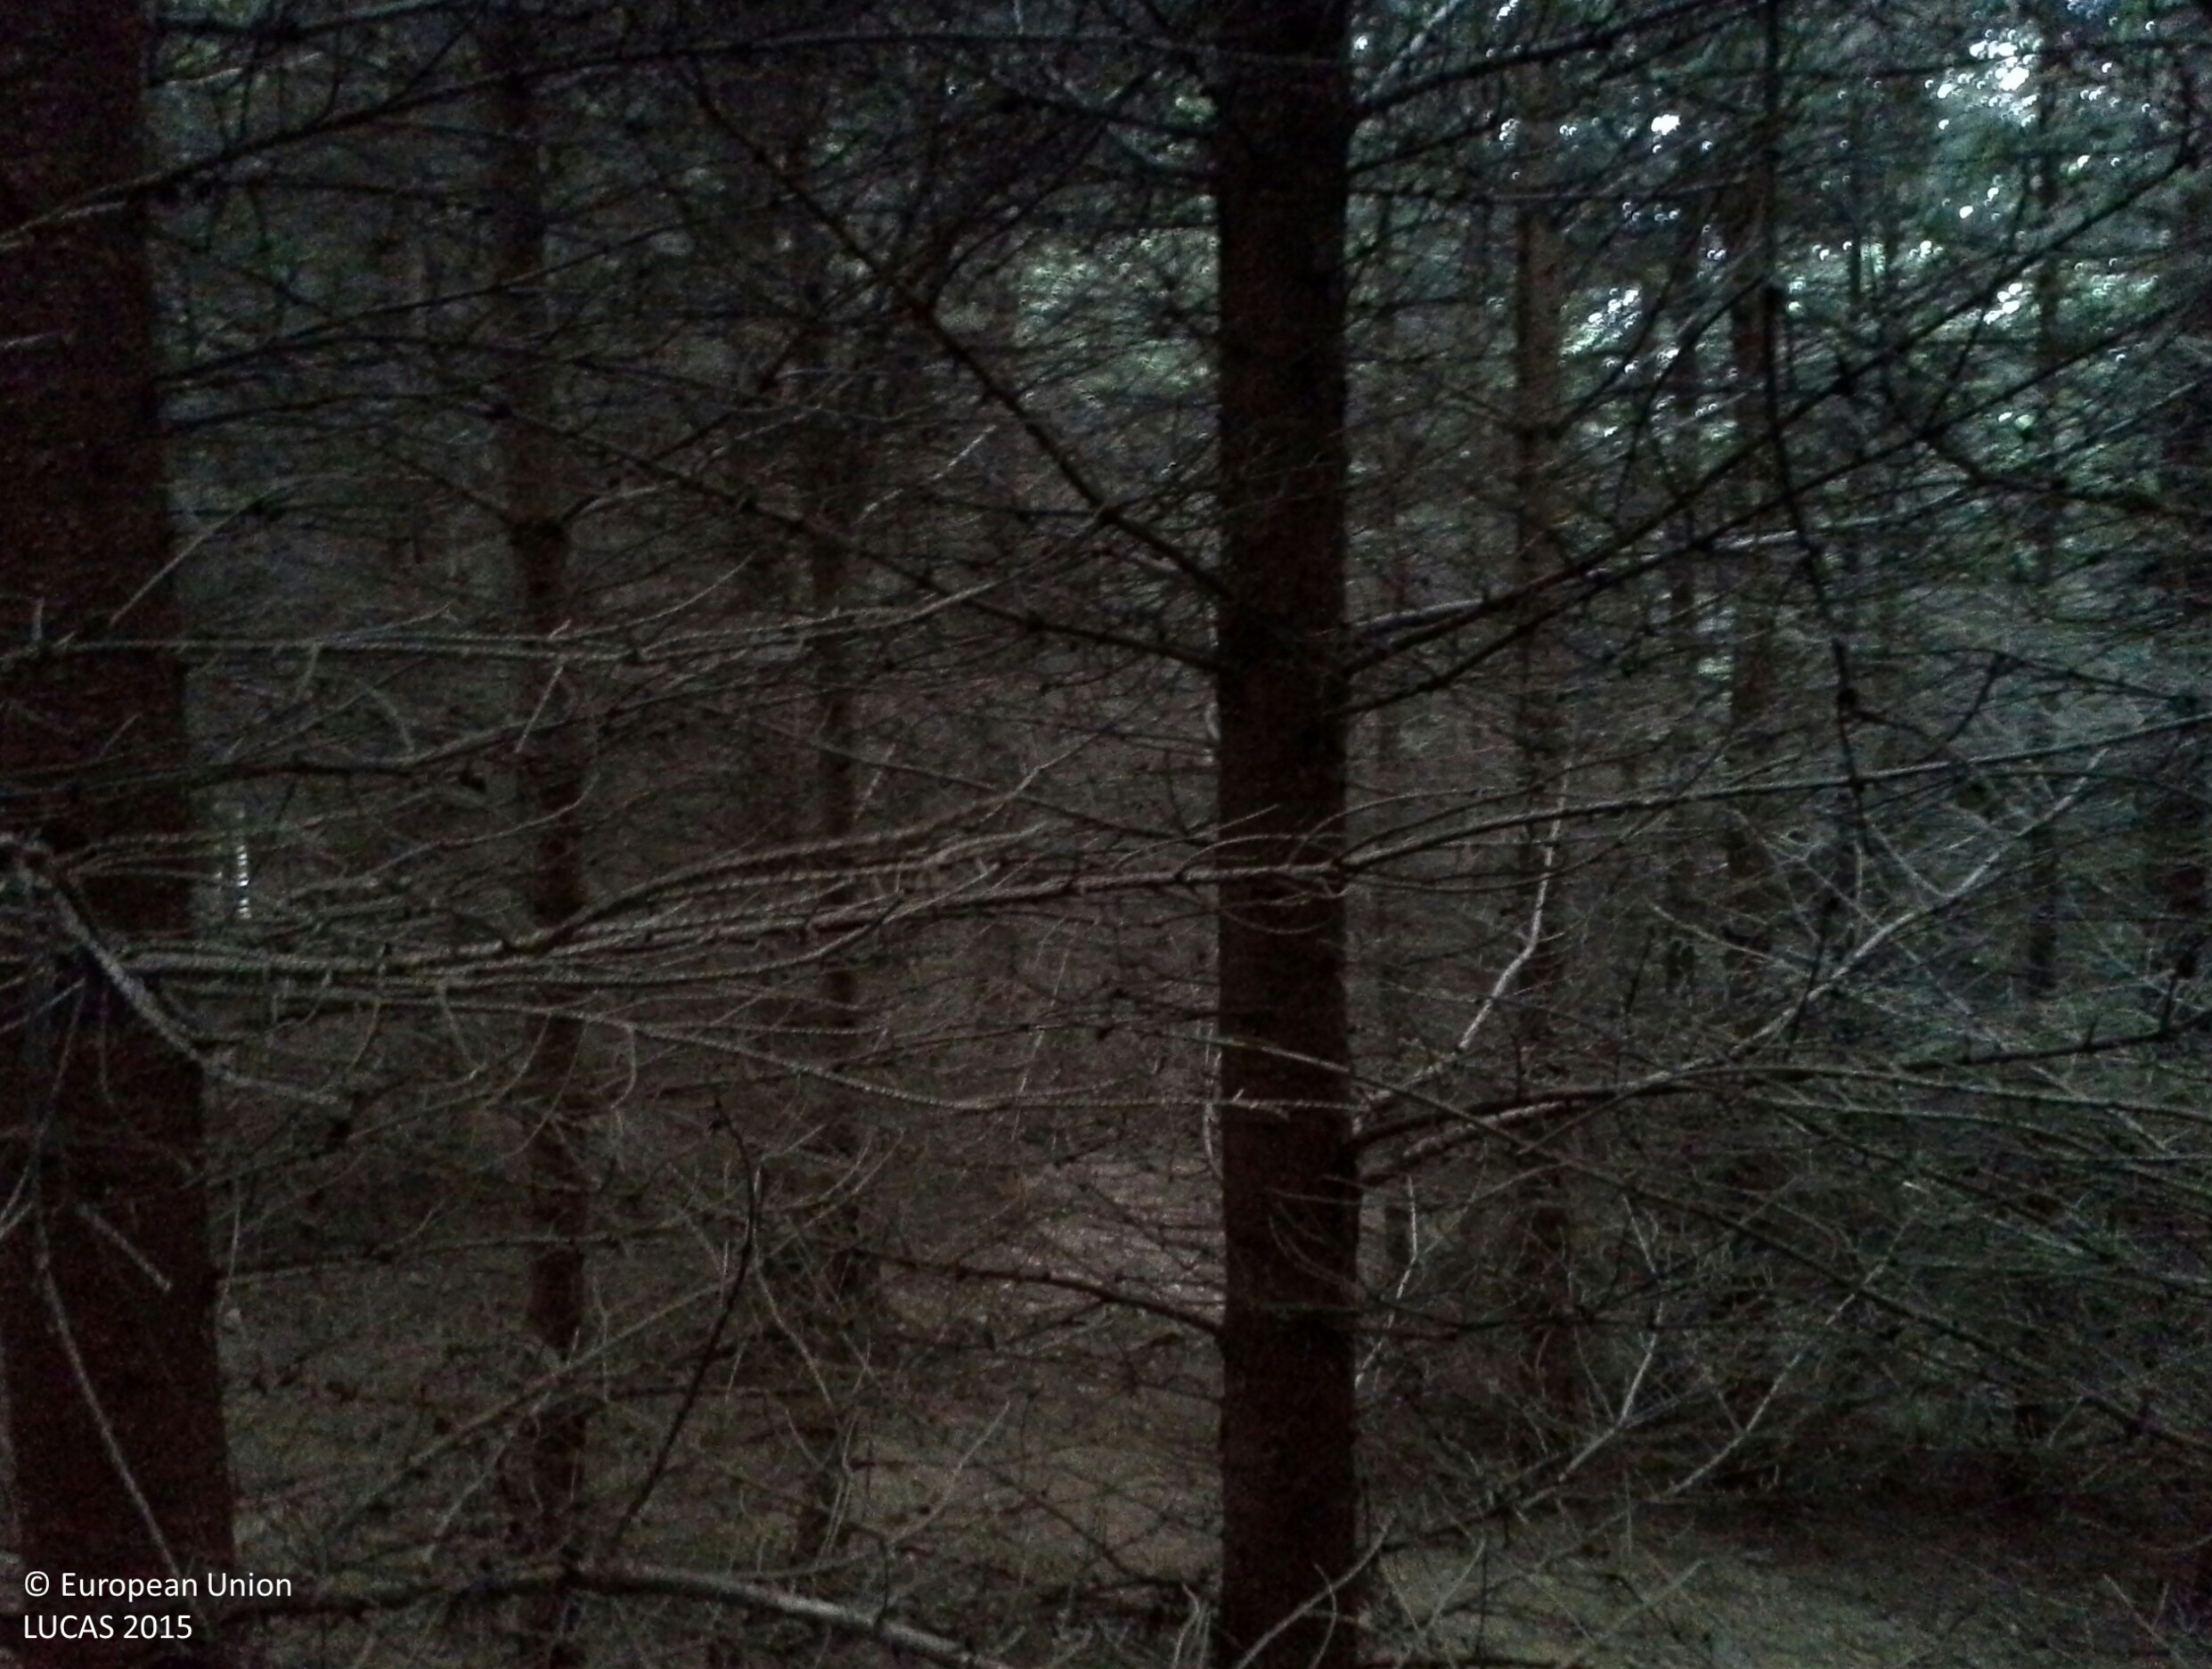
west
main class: Woodland
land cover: Spruce dominated coniferous woodland
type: hemiboreal forest and nemoral coniferous forest and mixed broadleaved-coniferous forest
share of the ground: > 75 %
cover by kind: coniferous forest trees 100 %
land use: Forestry
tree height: > 5 m
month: July
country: AT
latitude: 48.0149
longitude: 14.7060
